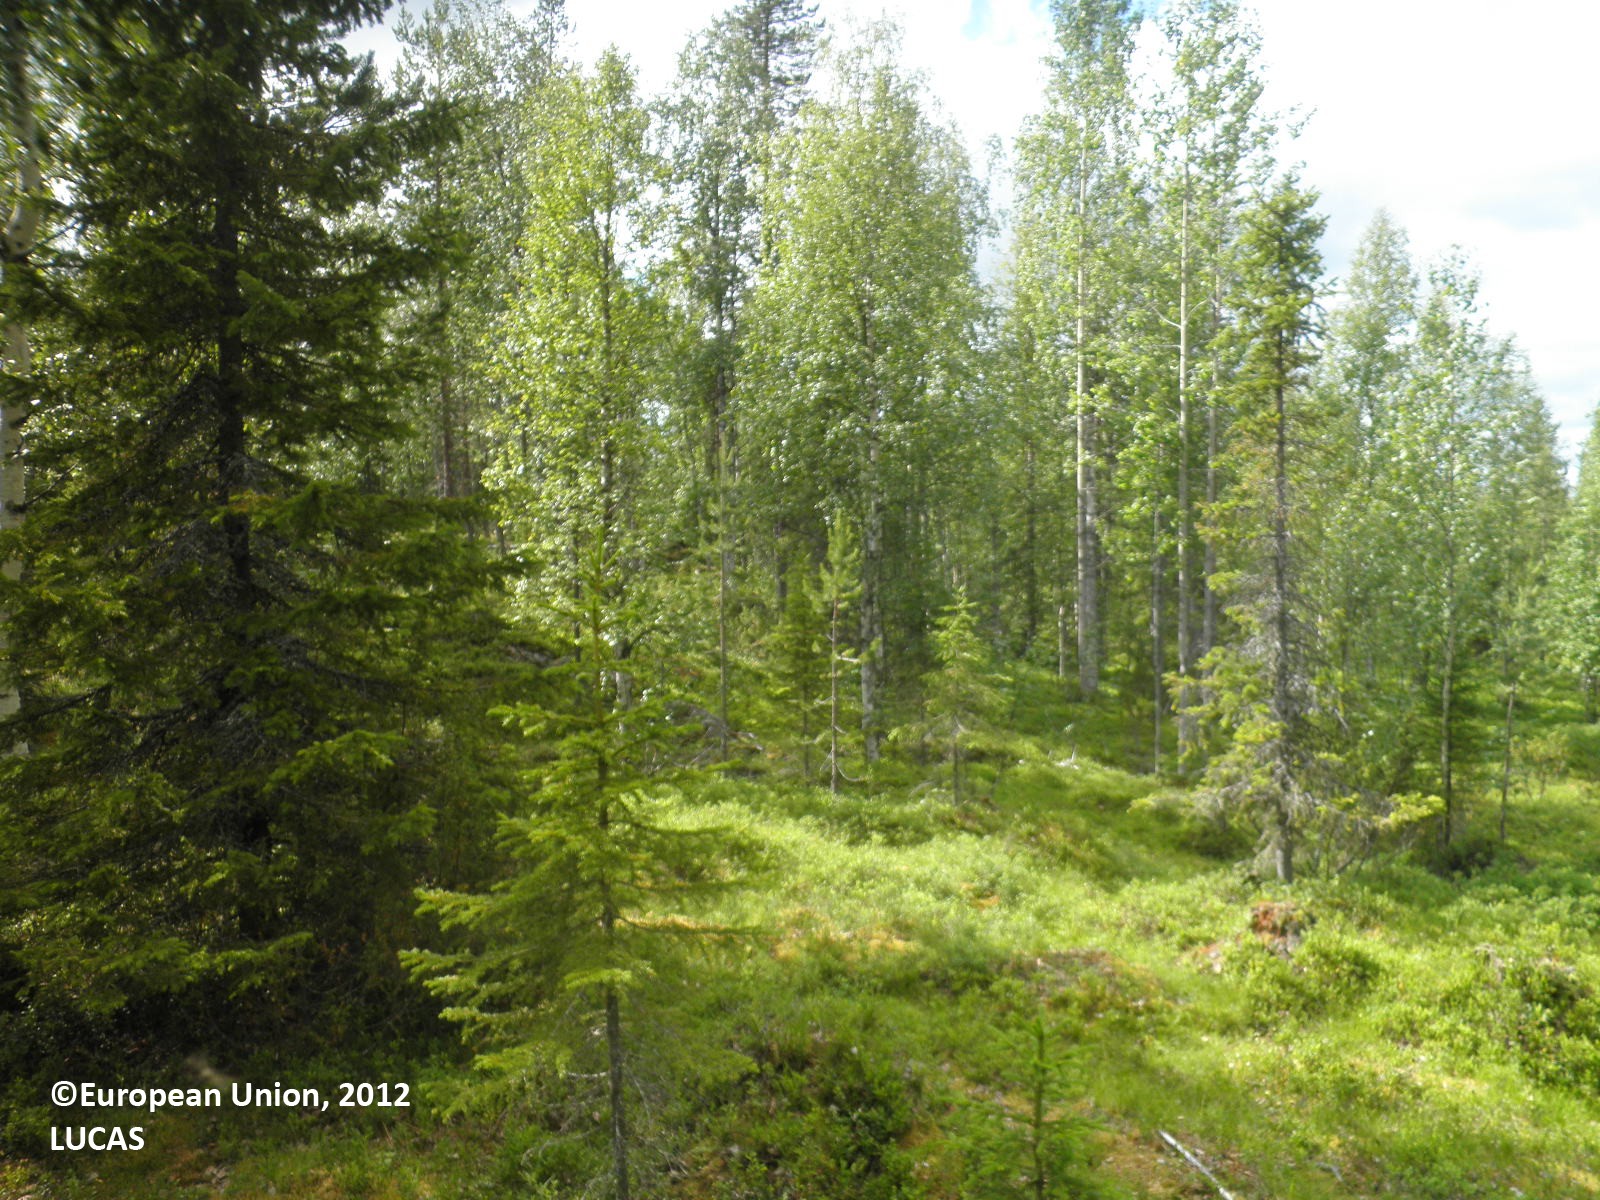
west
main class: Woodland
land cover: Spruce dominated mixed woodland
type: boreal forest
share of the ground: 50 - 75 %
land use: Forestry
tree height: > 5 m
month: July
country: FI
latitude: 67.6541
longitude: 25.8695
